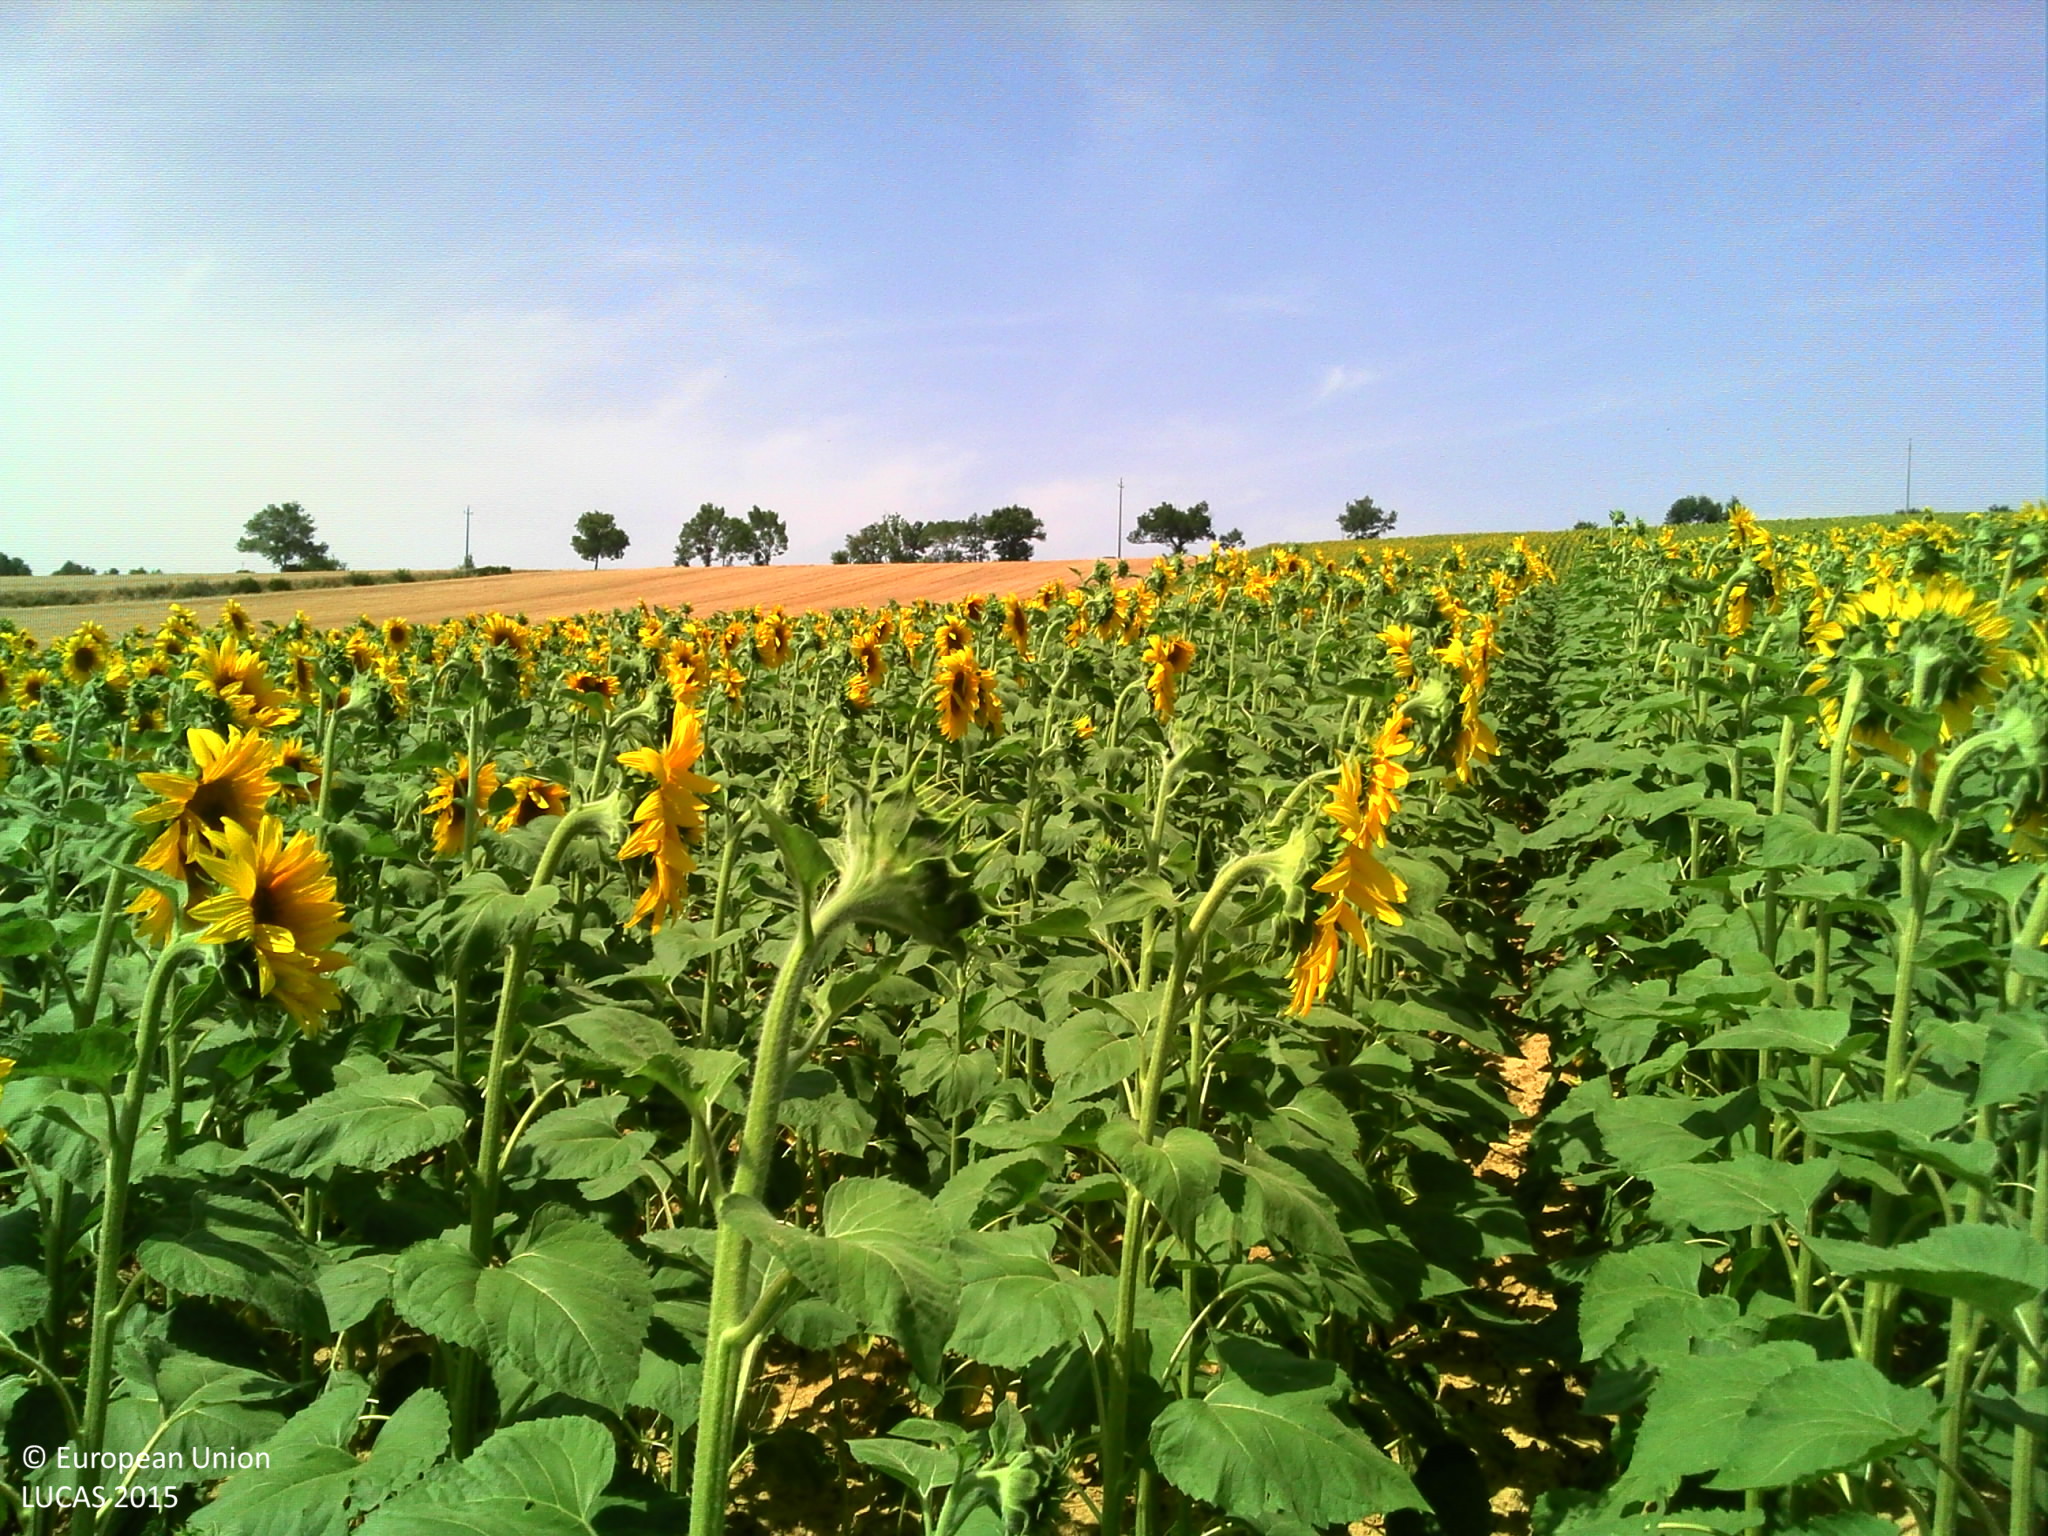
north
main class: Cropland
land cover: Sunflower
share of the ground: > 75 %
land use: Agriculture (excluding fallow land and kitchen gardens)
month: July
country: FR
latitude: 43.5375
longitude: 0.9543
